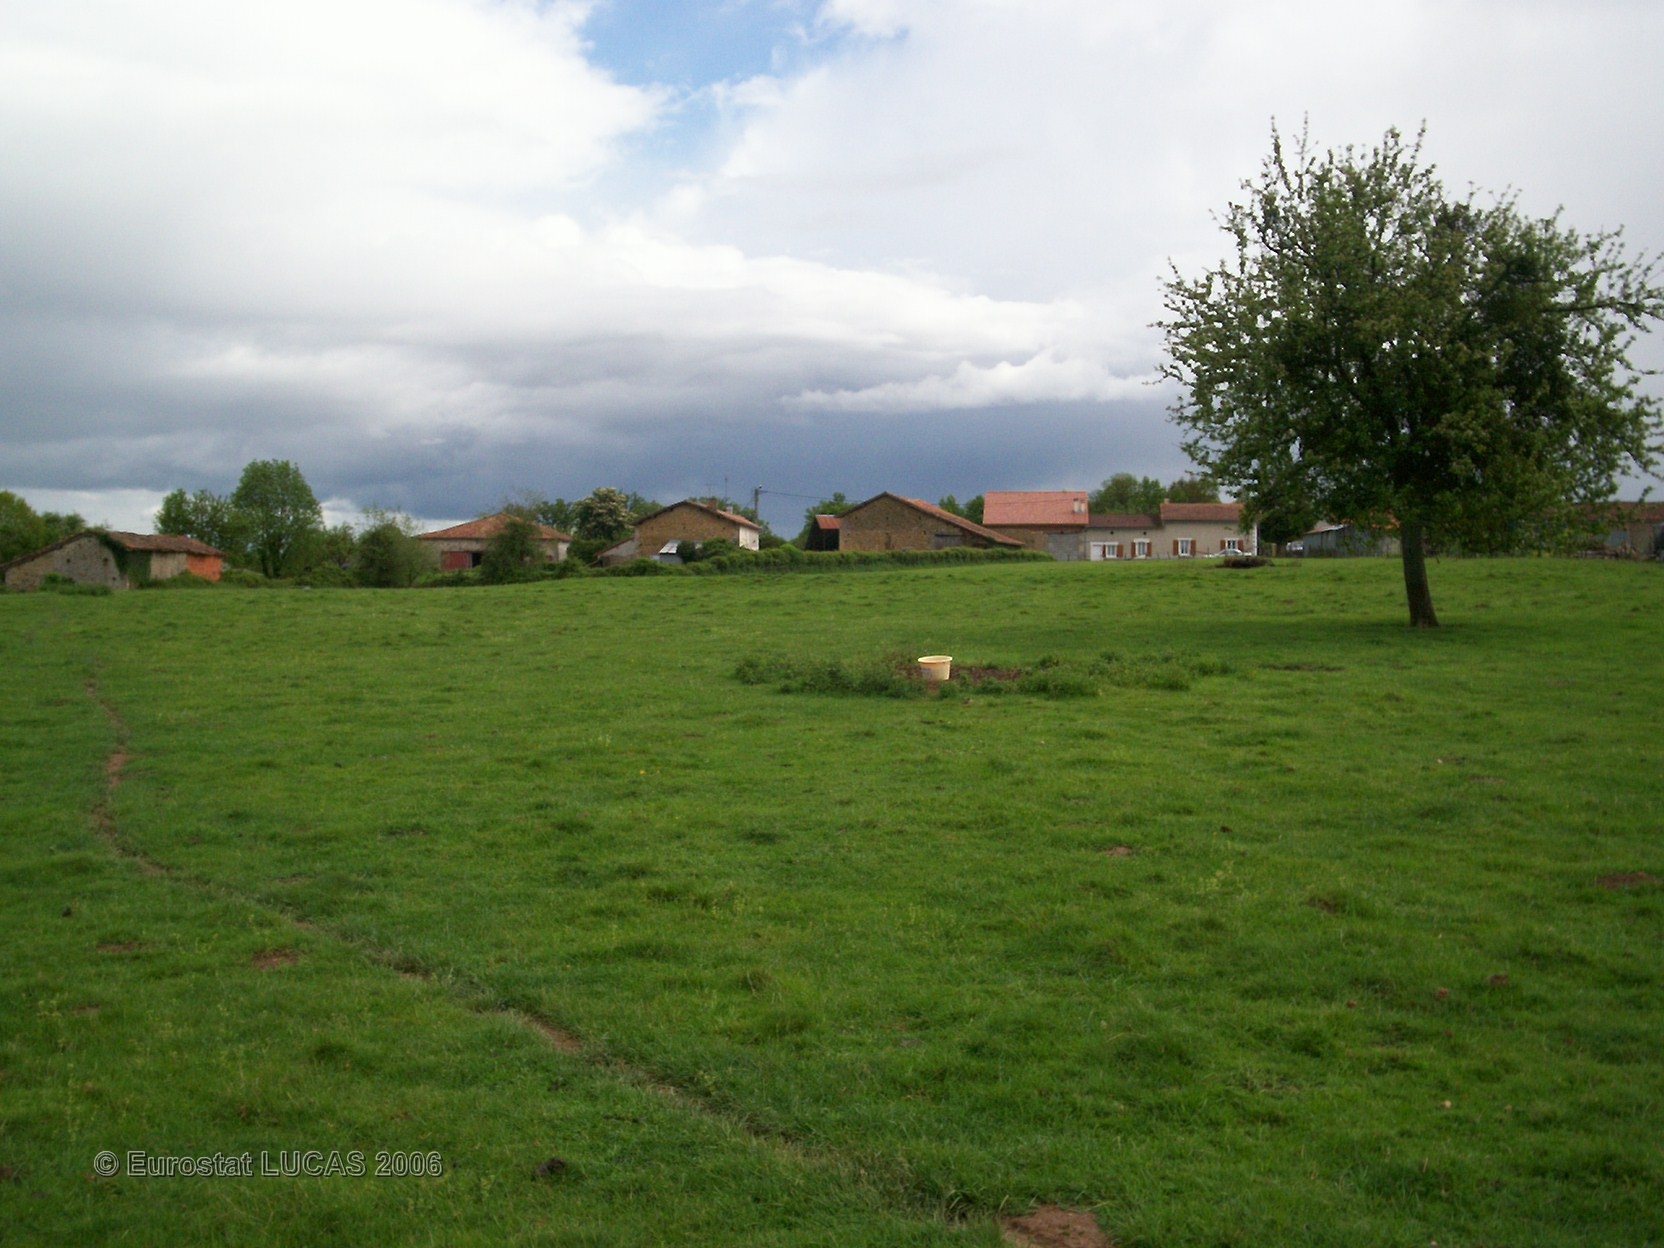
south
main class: Grassland
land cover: Grassland without tree/shrub cover
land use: Agriculture (excluding fallow land and kitchen gardens)
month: May
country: FR
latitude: 45.9661
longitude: 0.5260
